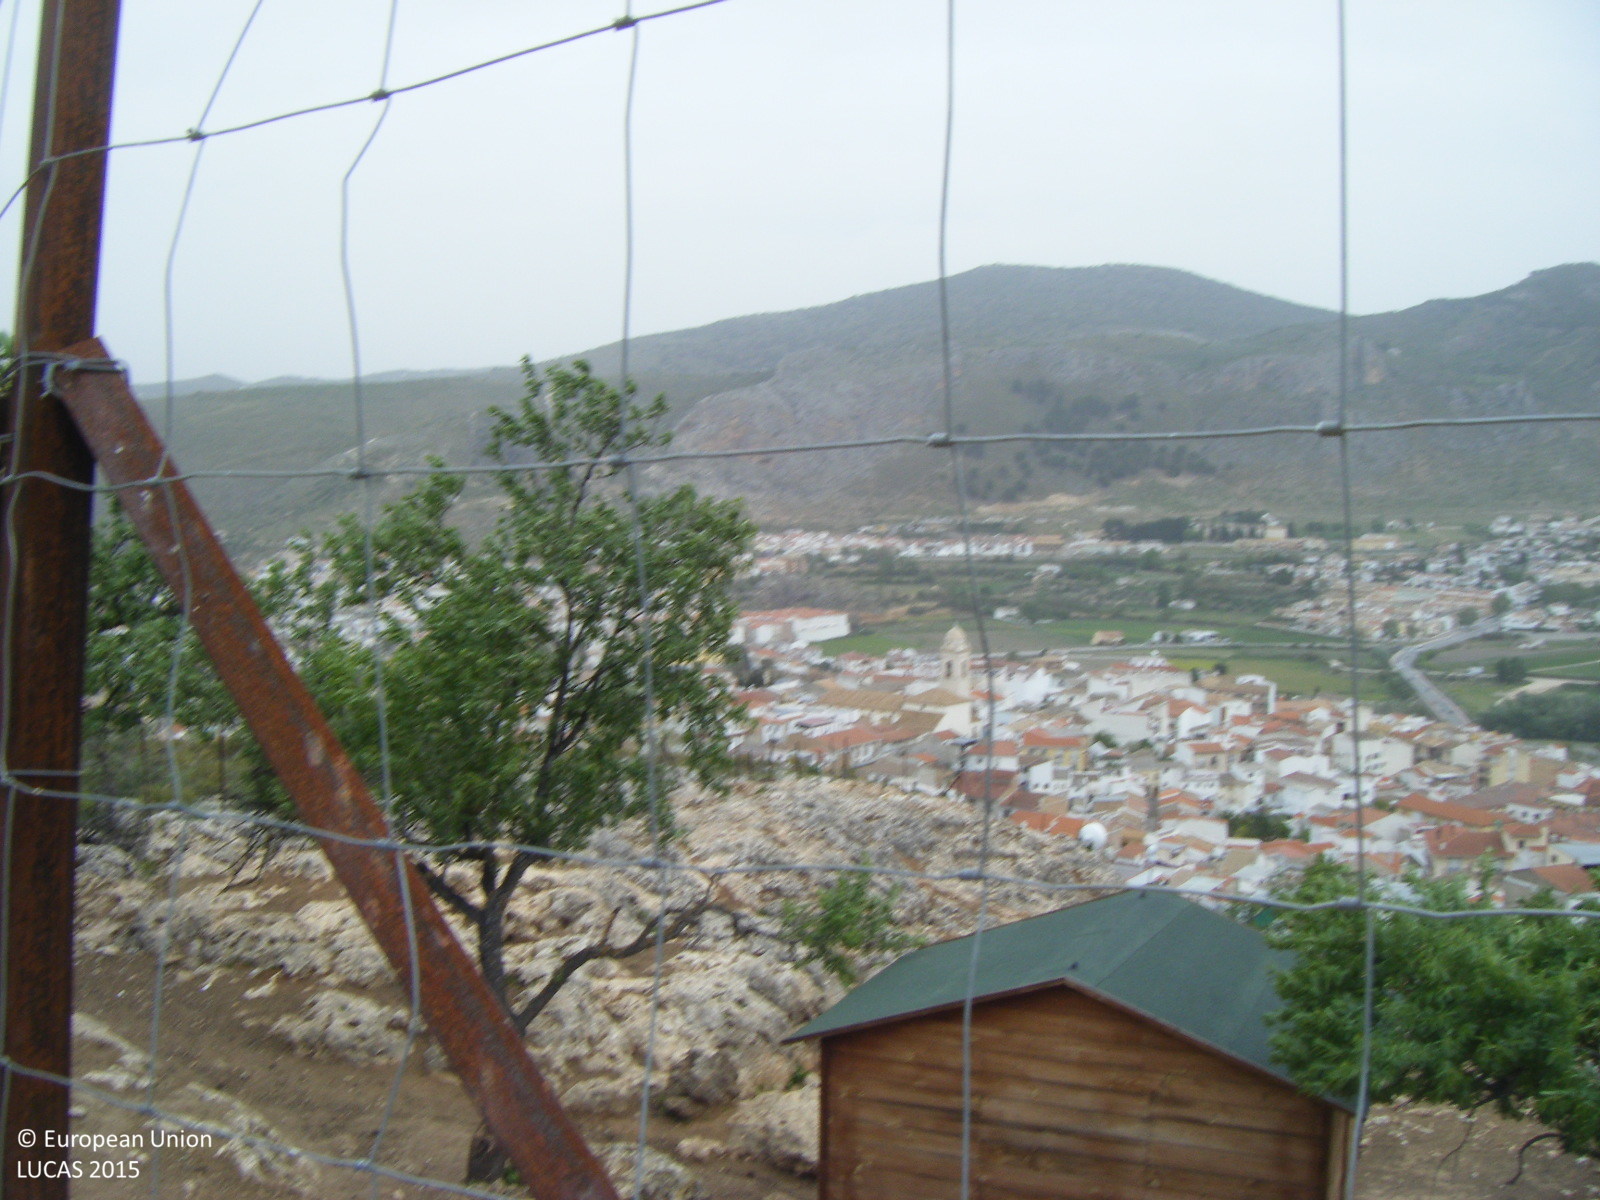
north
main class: Cropland
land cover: Nuts trees
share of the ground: < 10 %
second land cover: Other bare soil
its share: > 75 %
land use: Agriculture (excluding fallow land and kitchen gardens)
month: April
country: ES
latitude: 37.1616
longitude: -4.1495
